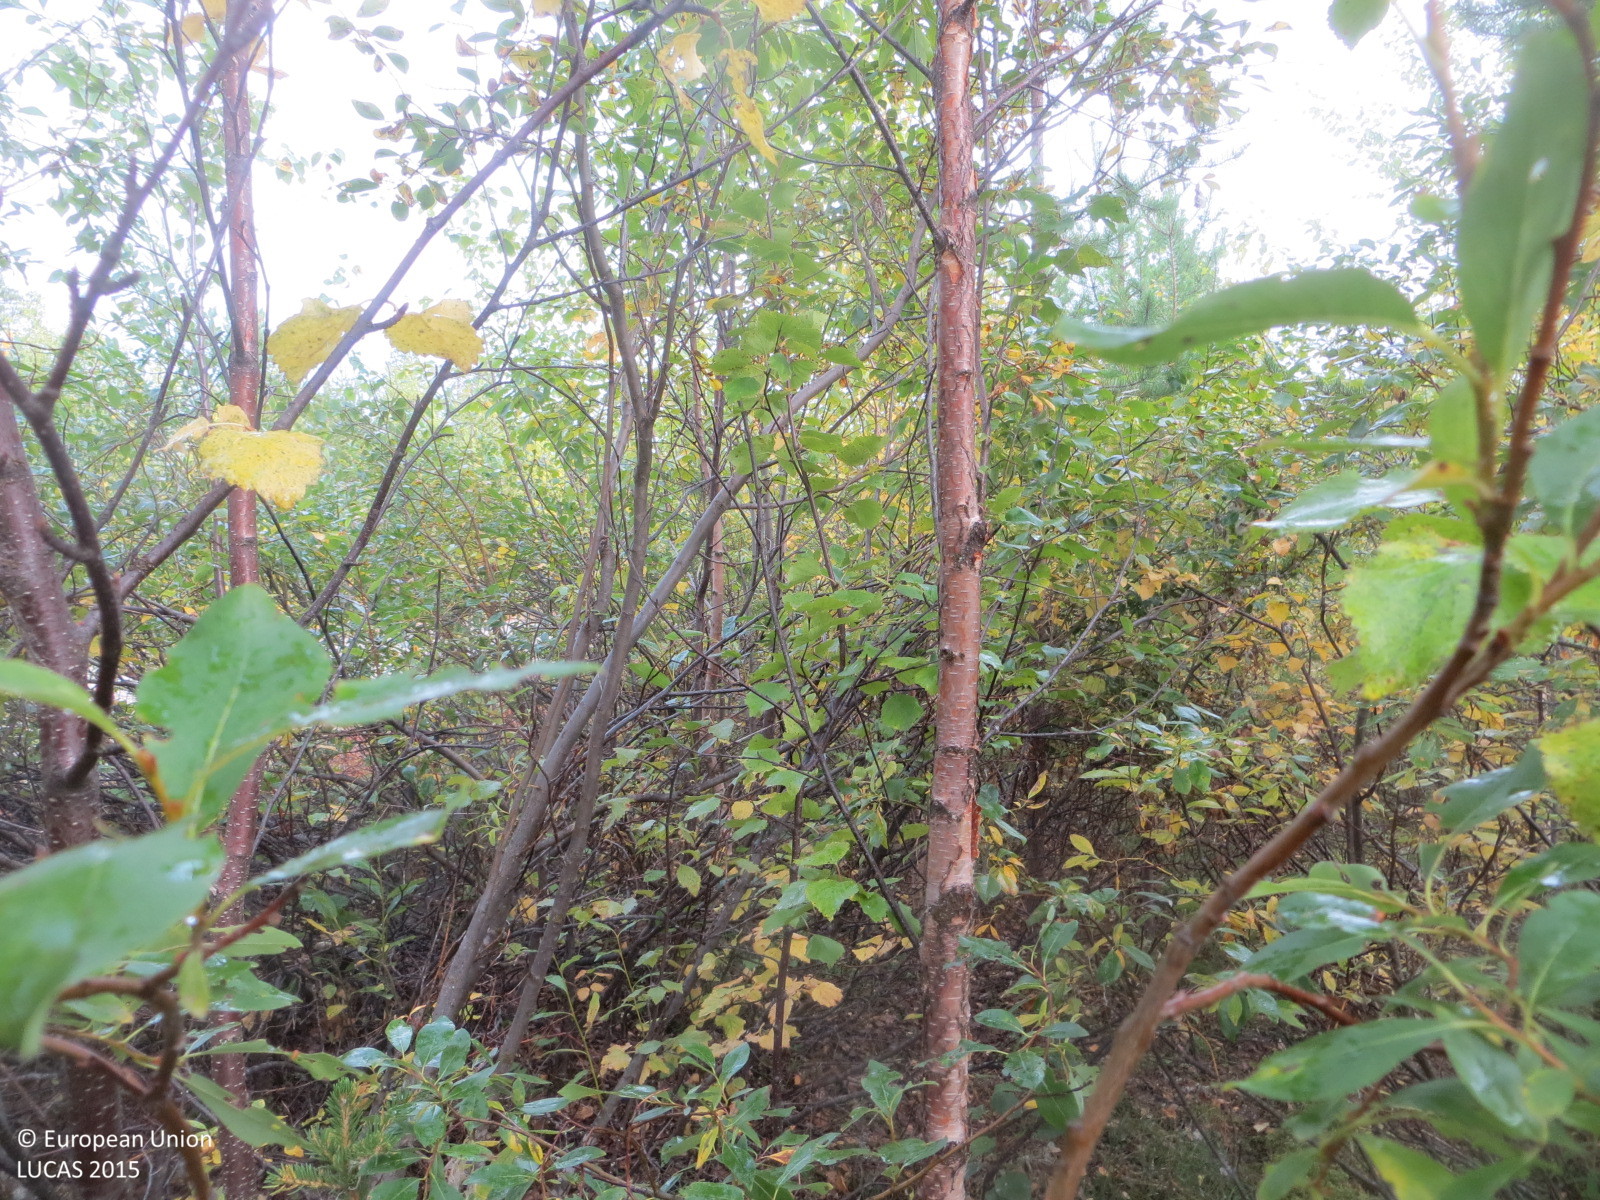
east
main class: Woodland
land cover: Pine dominated mixed woodland
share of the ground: > 75 %
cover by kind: coniferous forest trees 55 %, broadleaved forest trees 35 %, herbaceous plants 10 %
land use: Forestry
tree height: > 5 m
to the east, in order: Pine dominated mixed woodland; Sand; Tracks; Sand; Lines of trees; Ditches and canals; Other mixed woodland; Pine dominated coniferous woodland; Peatbogs
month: August
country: FI
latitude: 67.9941
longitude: 24.7349
